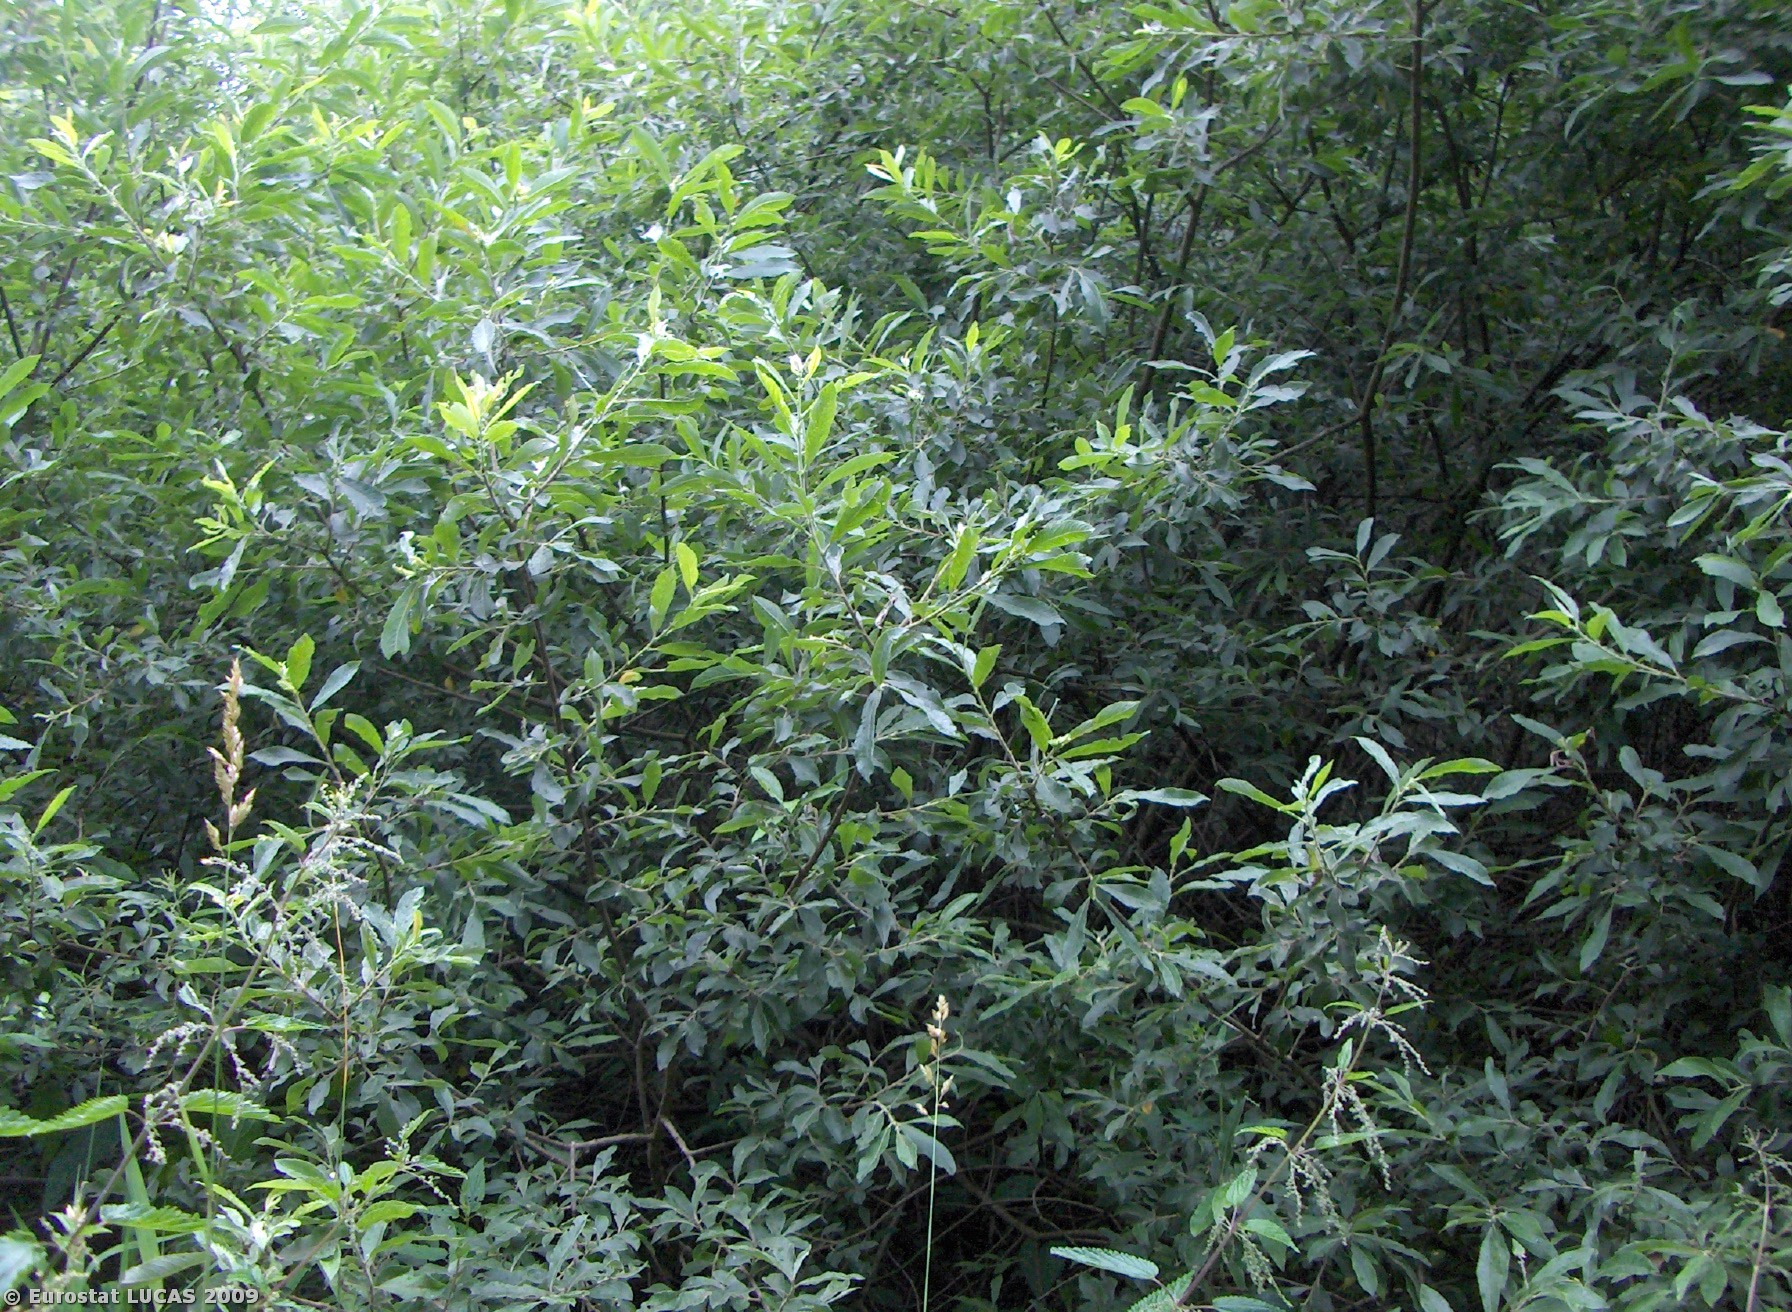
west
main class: Woodland
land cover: Mixed woodland
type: hemiboreal forest and nemoral coniferous forest and mixed broadleaved-coniferous forest
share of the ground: > 75 %
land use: Forestry
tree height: > 5 m
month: July
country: CZ
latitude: 49.4199
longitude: 13.1843
